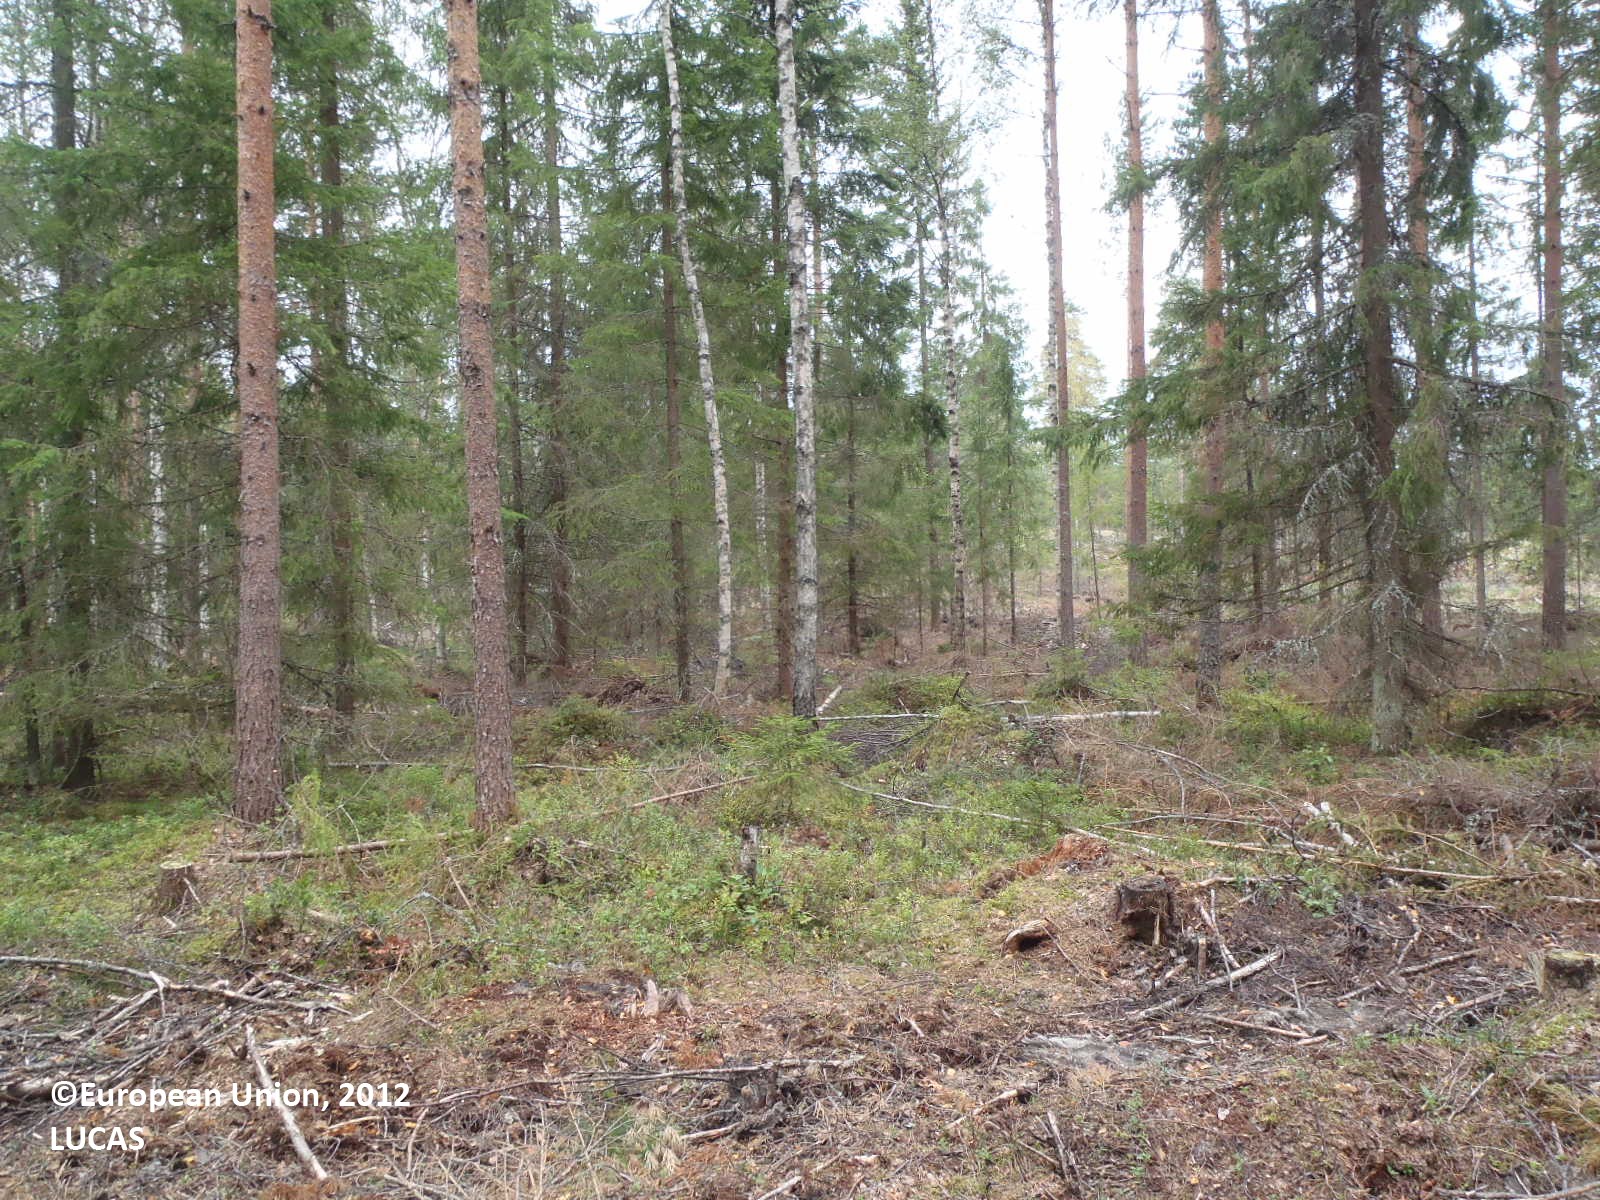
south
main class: Woodland
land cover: Pine dominated mixed woodland
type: boreal forest
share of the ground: > 75 %
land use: Forestry
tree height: > 5 m
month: August
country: FI
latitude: 60.8145
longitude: 22.4396
